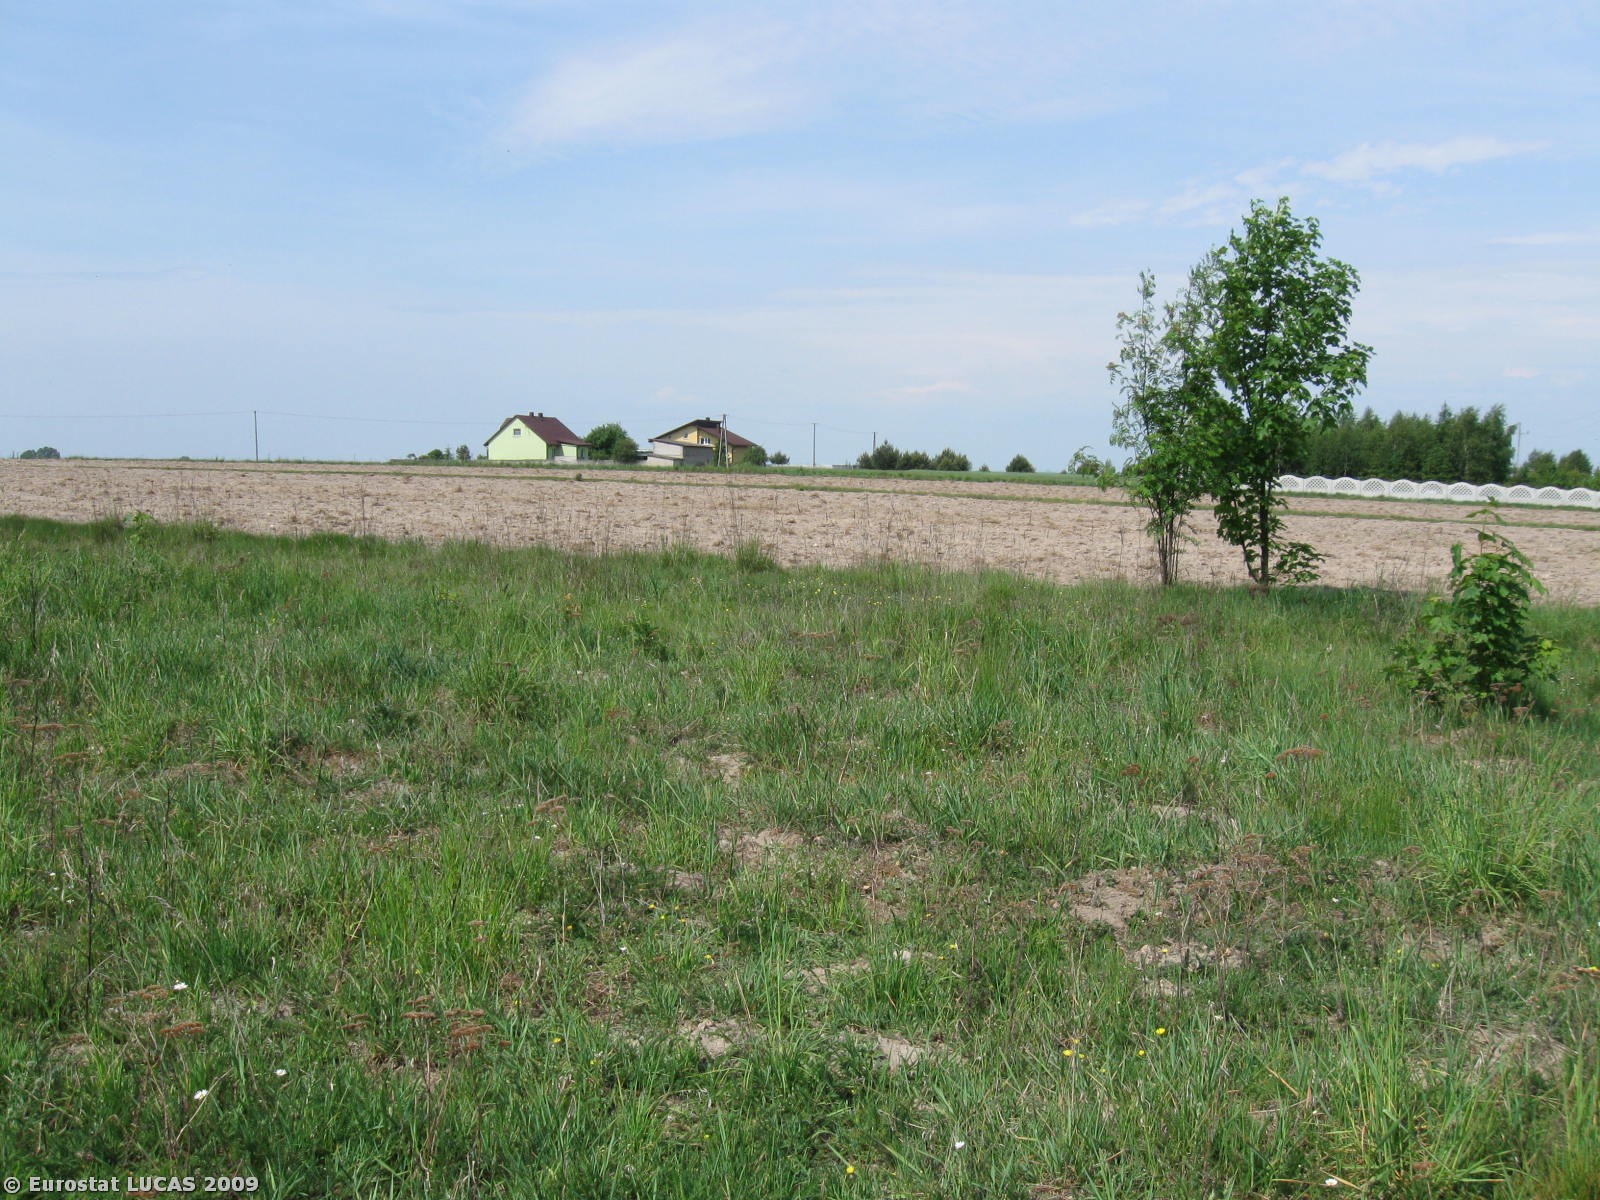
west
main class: Grassland
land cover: Grassland without tree/shrub cover
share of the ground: 50 - 75 %
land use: Unused
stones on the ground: 25 - 50 %
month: May
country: PL
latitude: 50.7260
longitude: 20.3638
